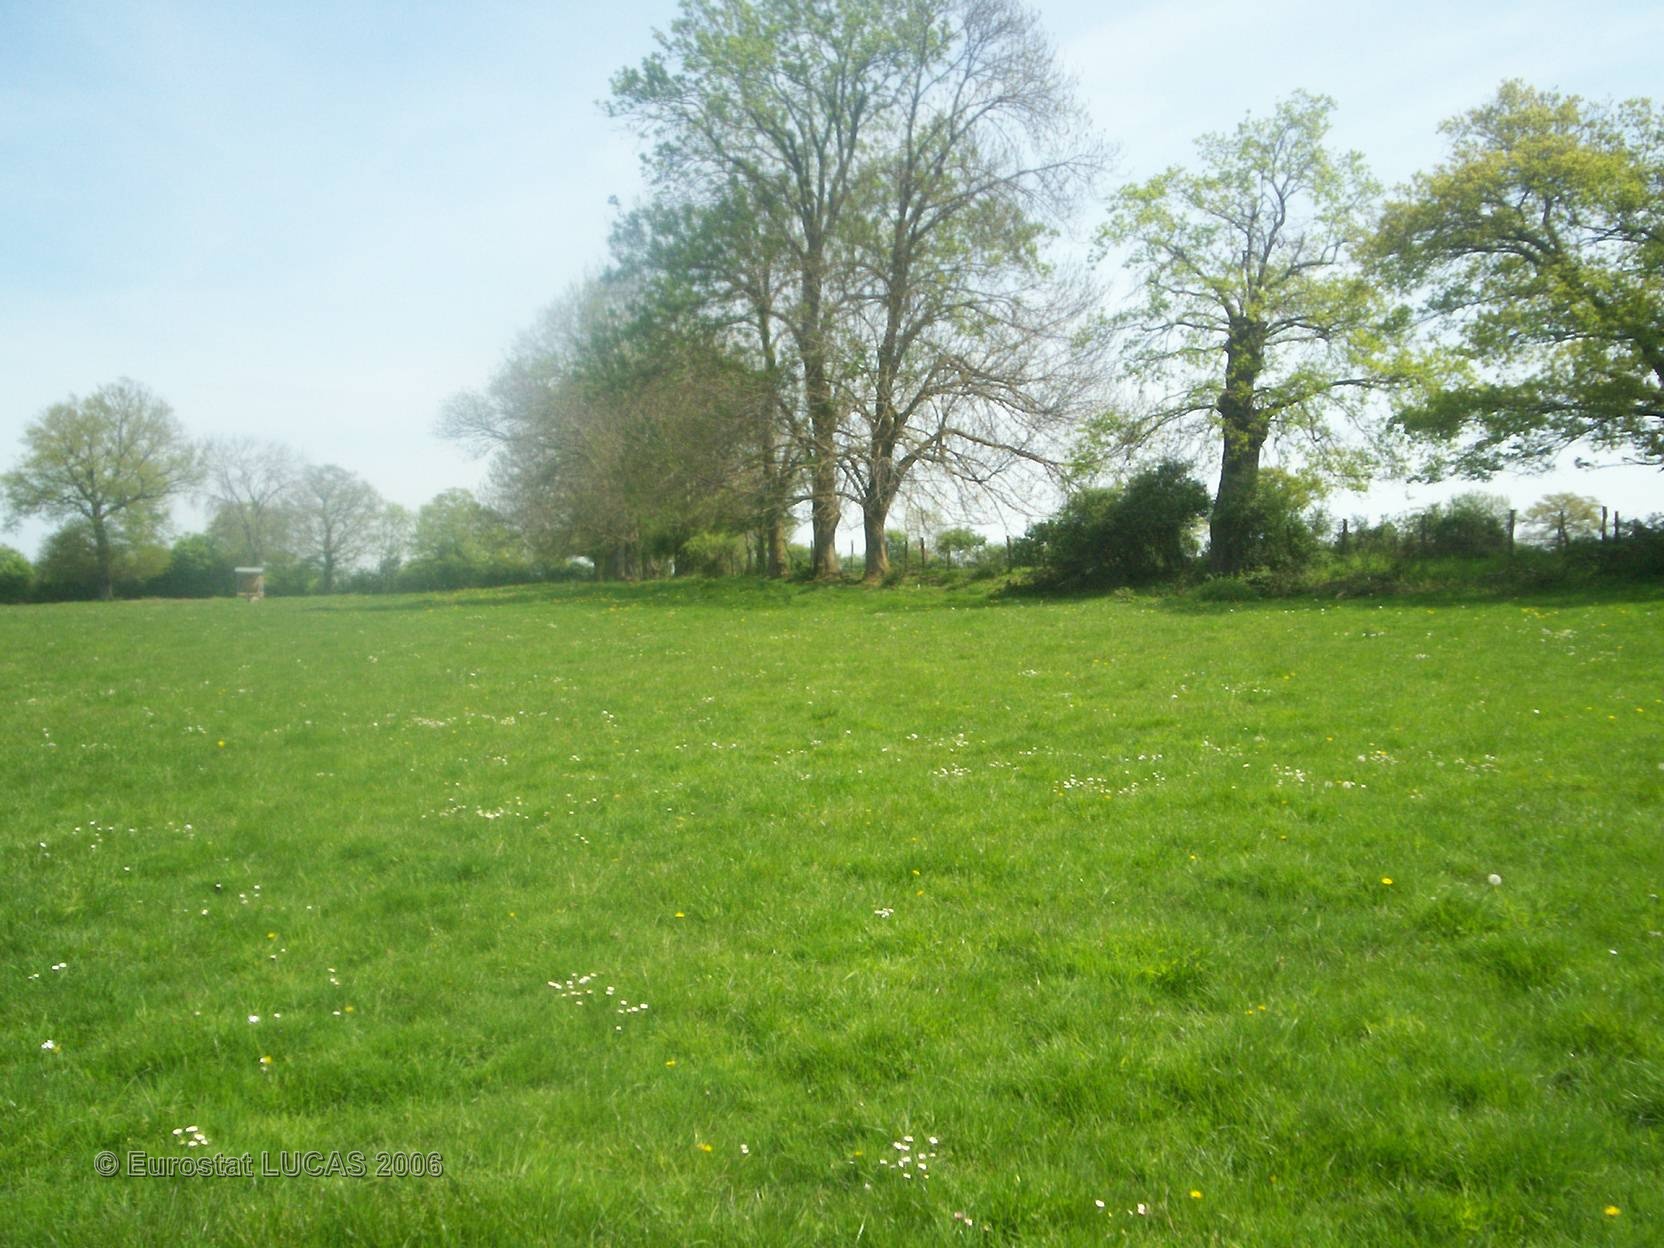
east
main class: Grassland
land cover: Grassland without tree/shrub cover
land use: Agriculture (excluding fallow land and kitchen gardens)
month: May
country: FR
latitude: 46.4935
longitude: 3.1577
